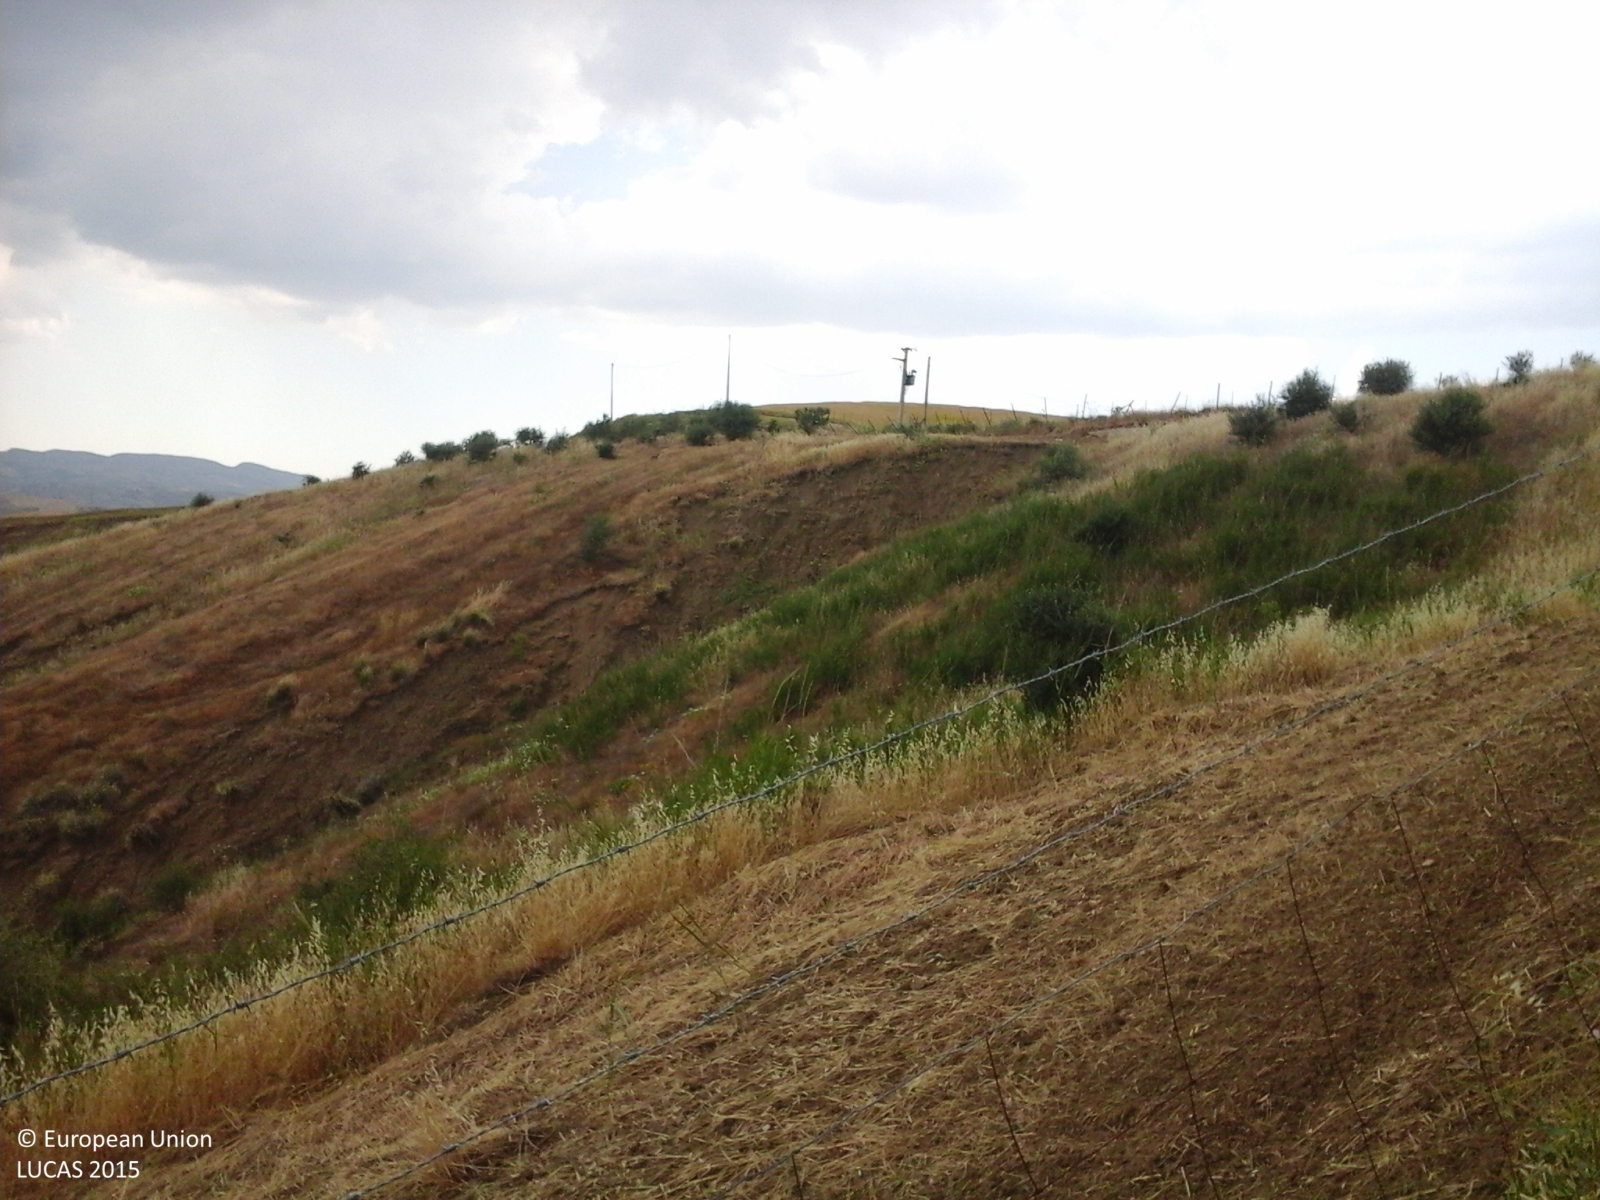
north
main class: Woodland
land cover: Broadleaved woodland
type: broadleaved evergreen forest
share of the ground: 10 - 25 %
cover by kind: herbaceous plants 80 %, broadleaved forest trees 20 %
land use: Forestry
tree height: < 5 m
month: June
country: IT
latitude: 37.5176
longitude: 14.0092
